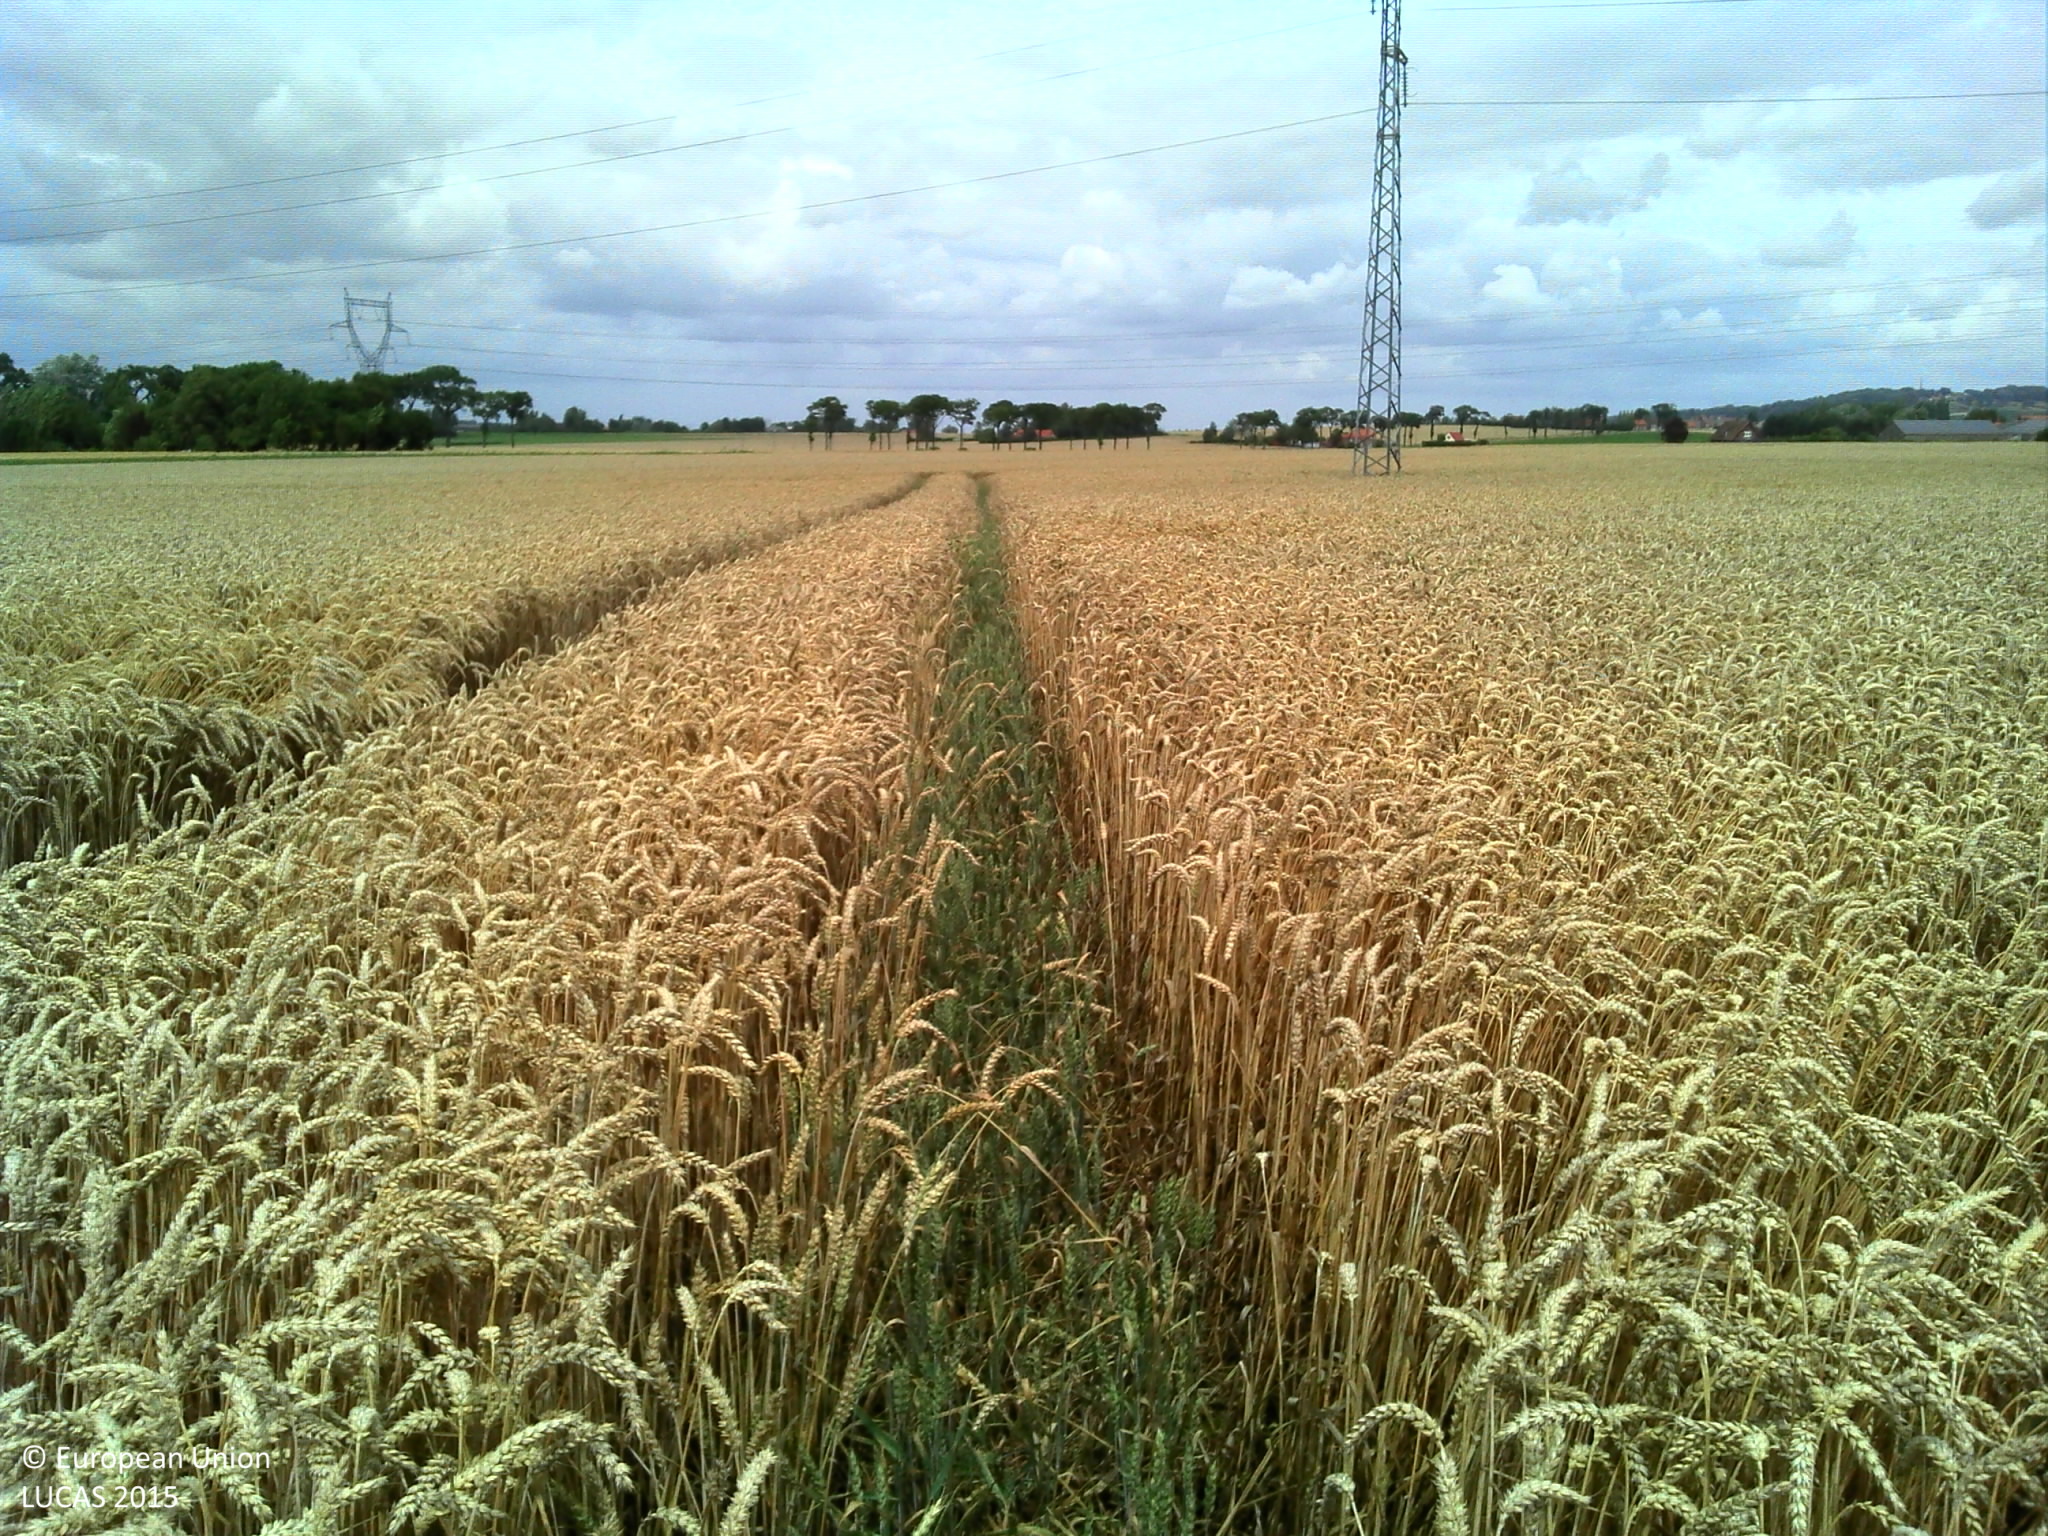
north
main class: Cropland
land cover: Common wheat
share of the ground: > 75 %
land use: Agriculture (excluding fallow land and kitchen gardens)
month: July
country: FR
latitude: 50.7632
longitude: 2.4302
